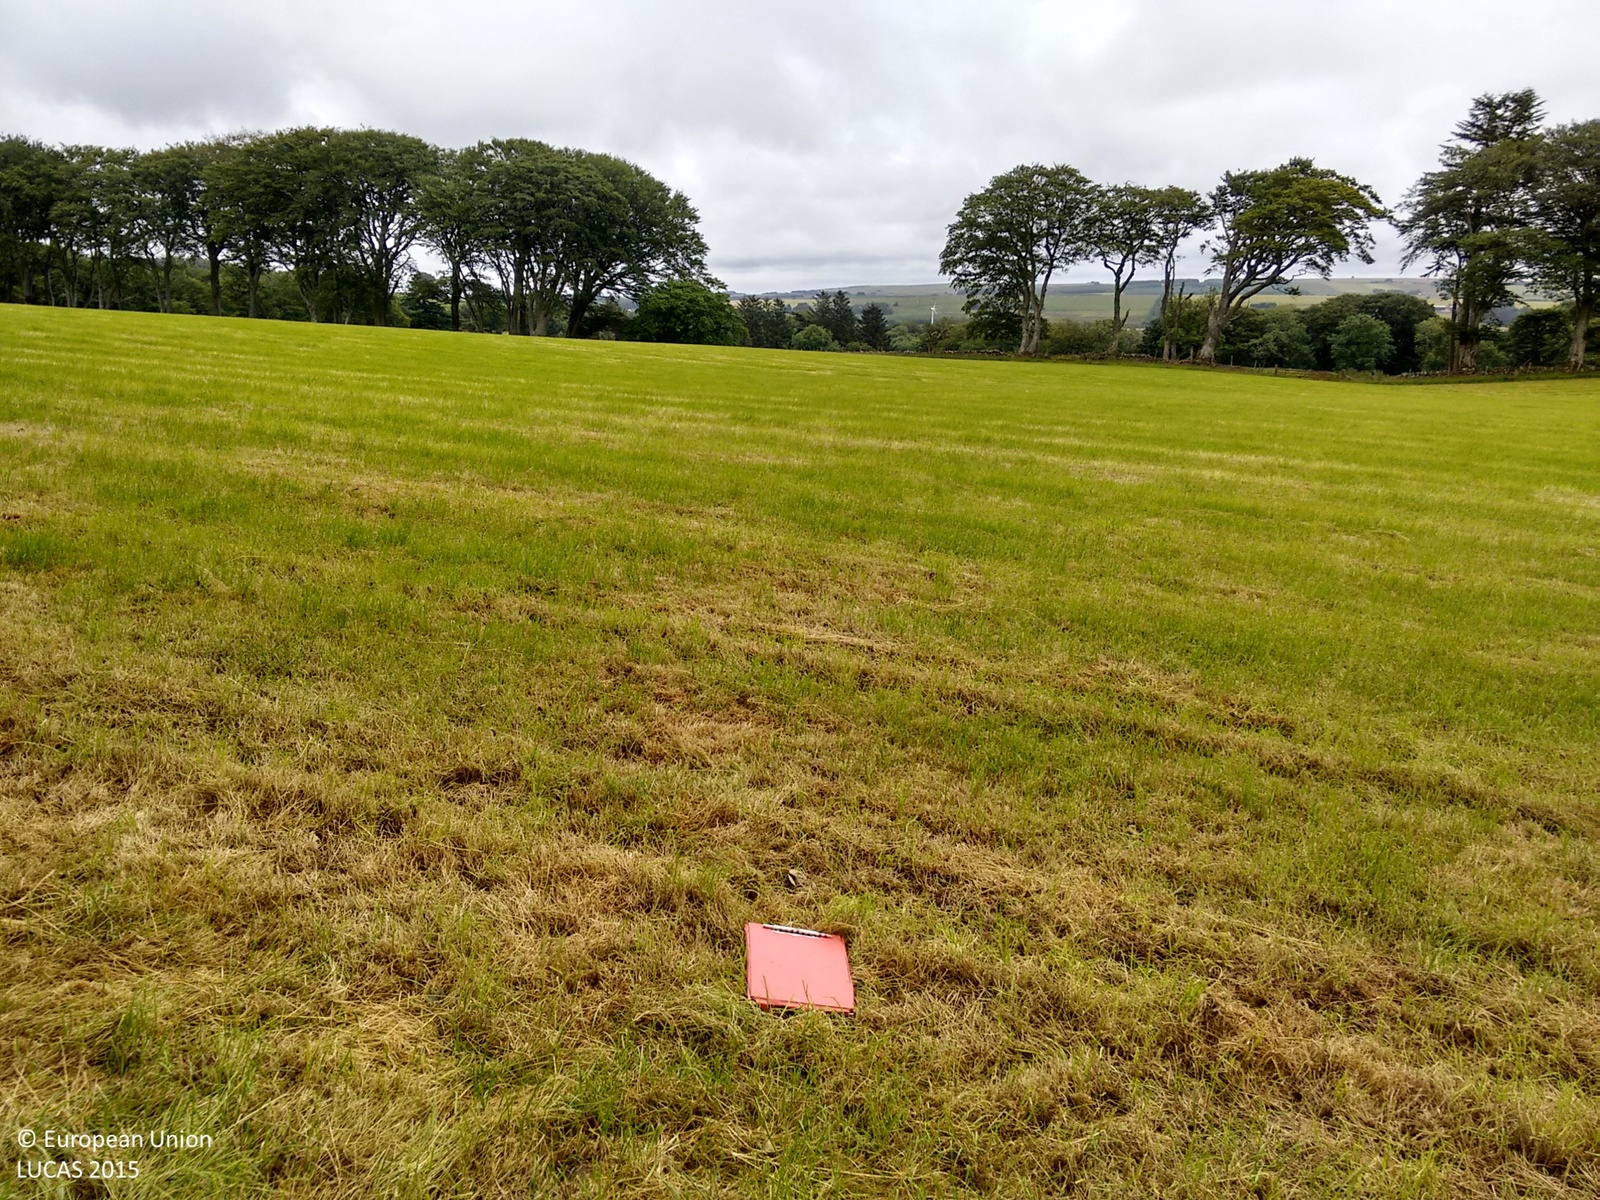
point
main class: Grassland
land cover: Grassland without tree/shrub cover
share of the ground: > 75 %
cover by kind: herbaceous plants 100 %
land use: Agriculture (excluding fallow land and kitchen gardens)
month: July
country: GB
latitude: 57.5960
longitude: -2.3132
